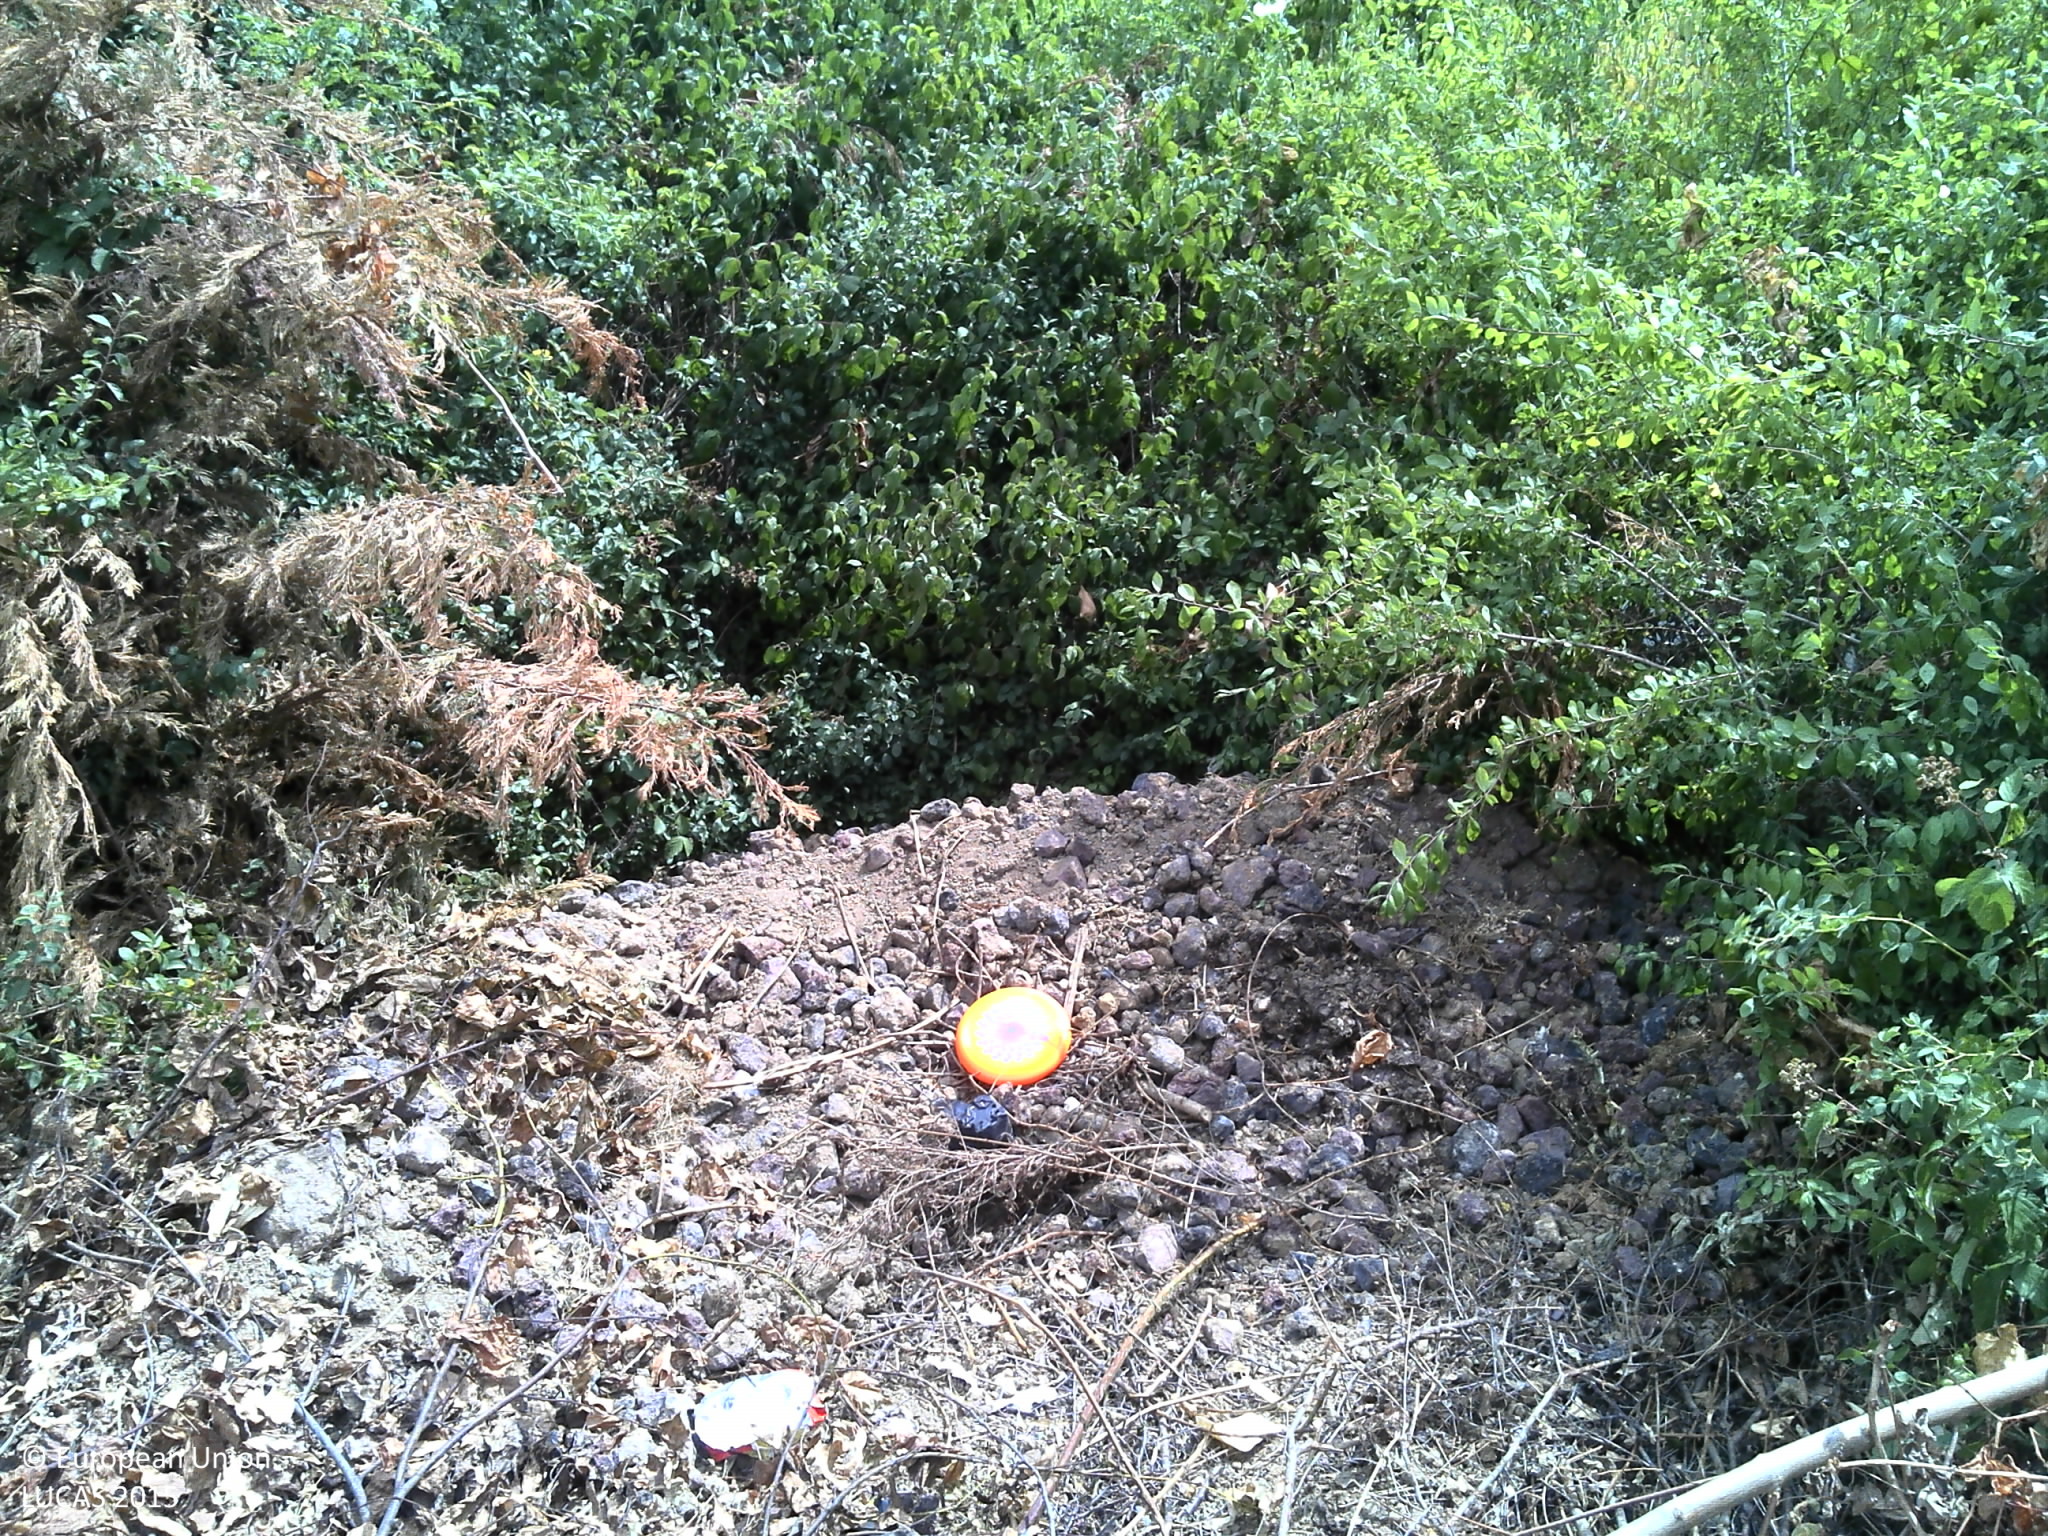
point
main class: Woodland
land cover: Broadleaved woodland
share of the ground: > 75 %
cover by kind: shrubs 80 %, broadleaved forest trees 20 %
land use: Semi-natural and natural areas not in use
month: July
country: FR
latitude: 48.6139
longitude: 2.4336
